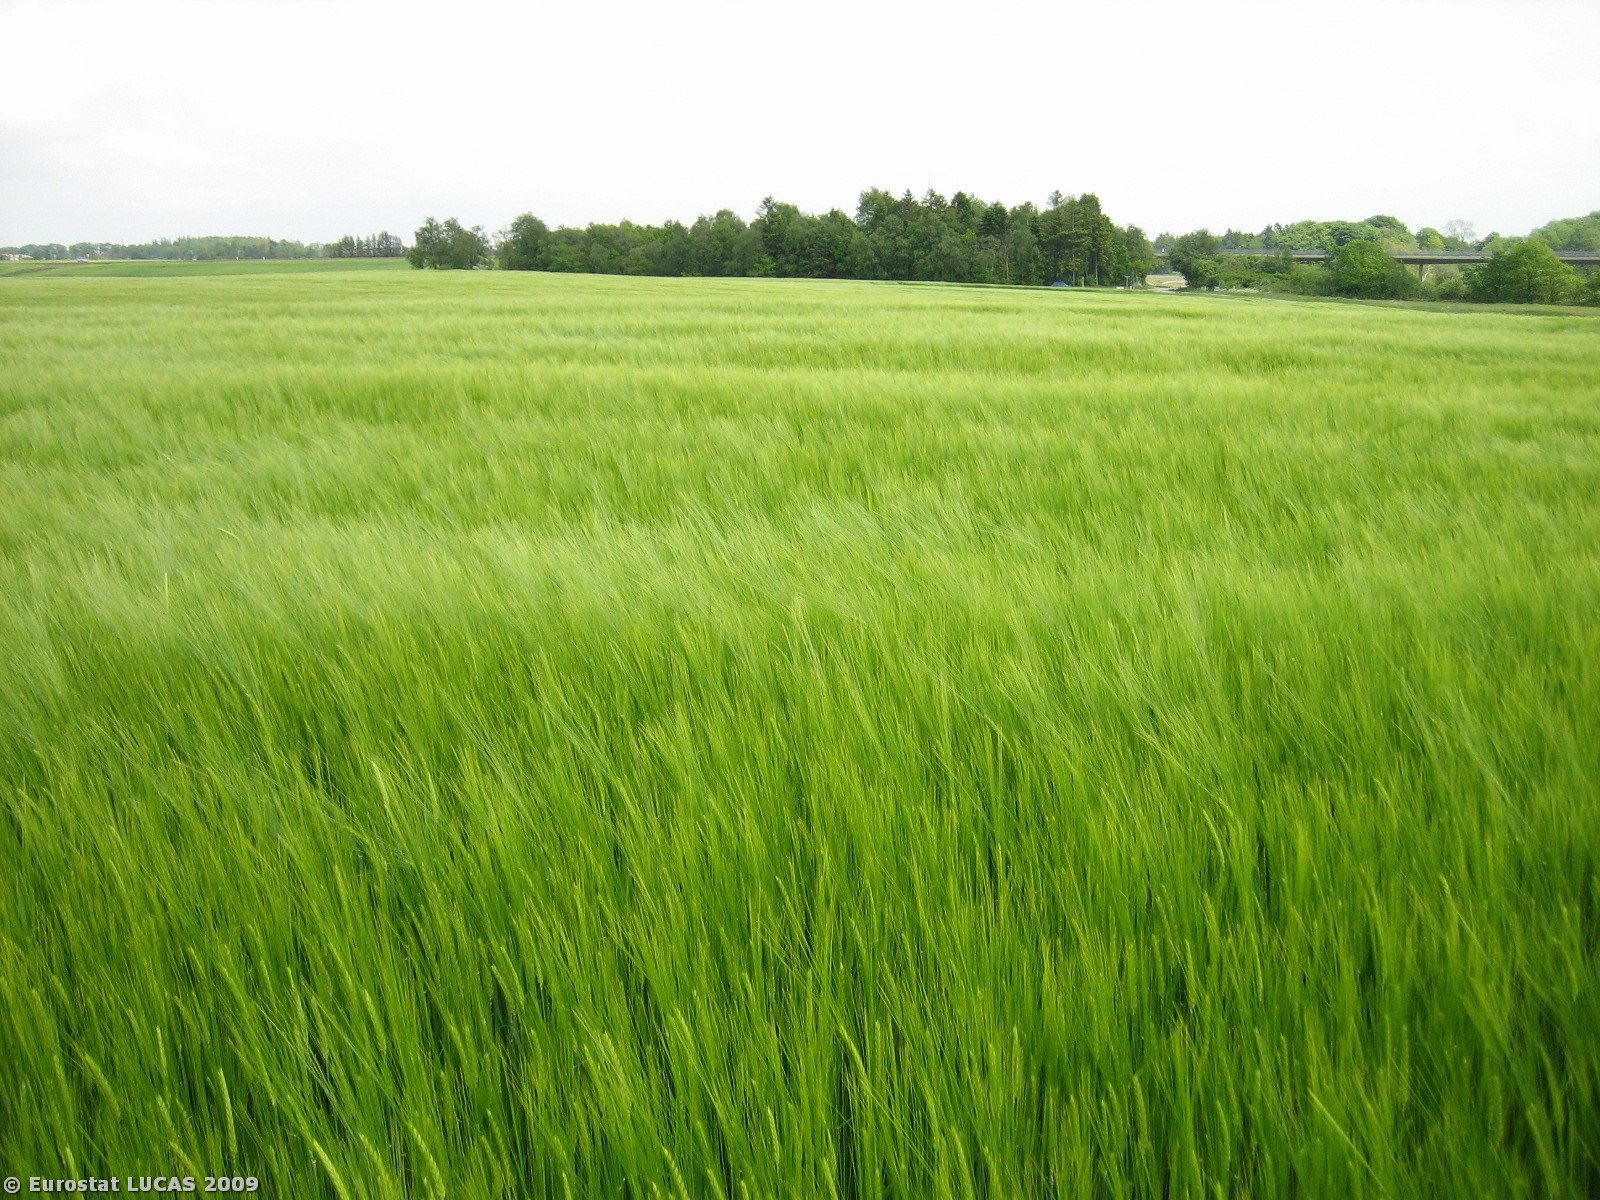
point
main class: Cropland
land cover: Barley
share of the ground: > 75 %
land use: Agriculture (excluding fallow land and kitchen gardens)
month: May
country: DK
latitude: 55.8079
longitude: 9.2190
